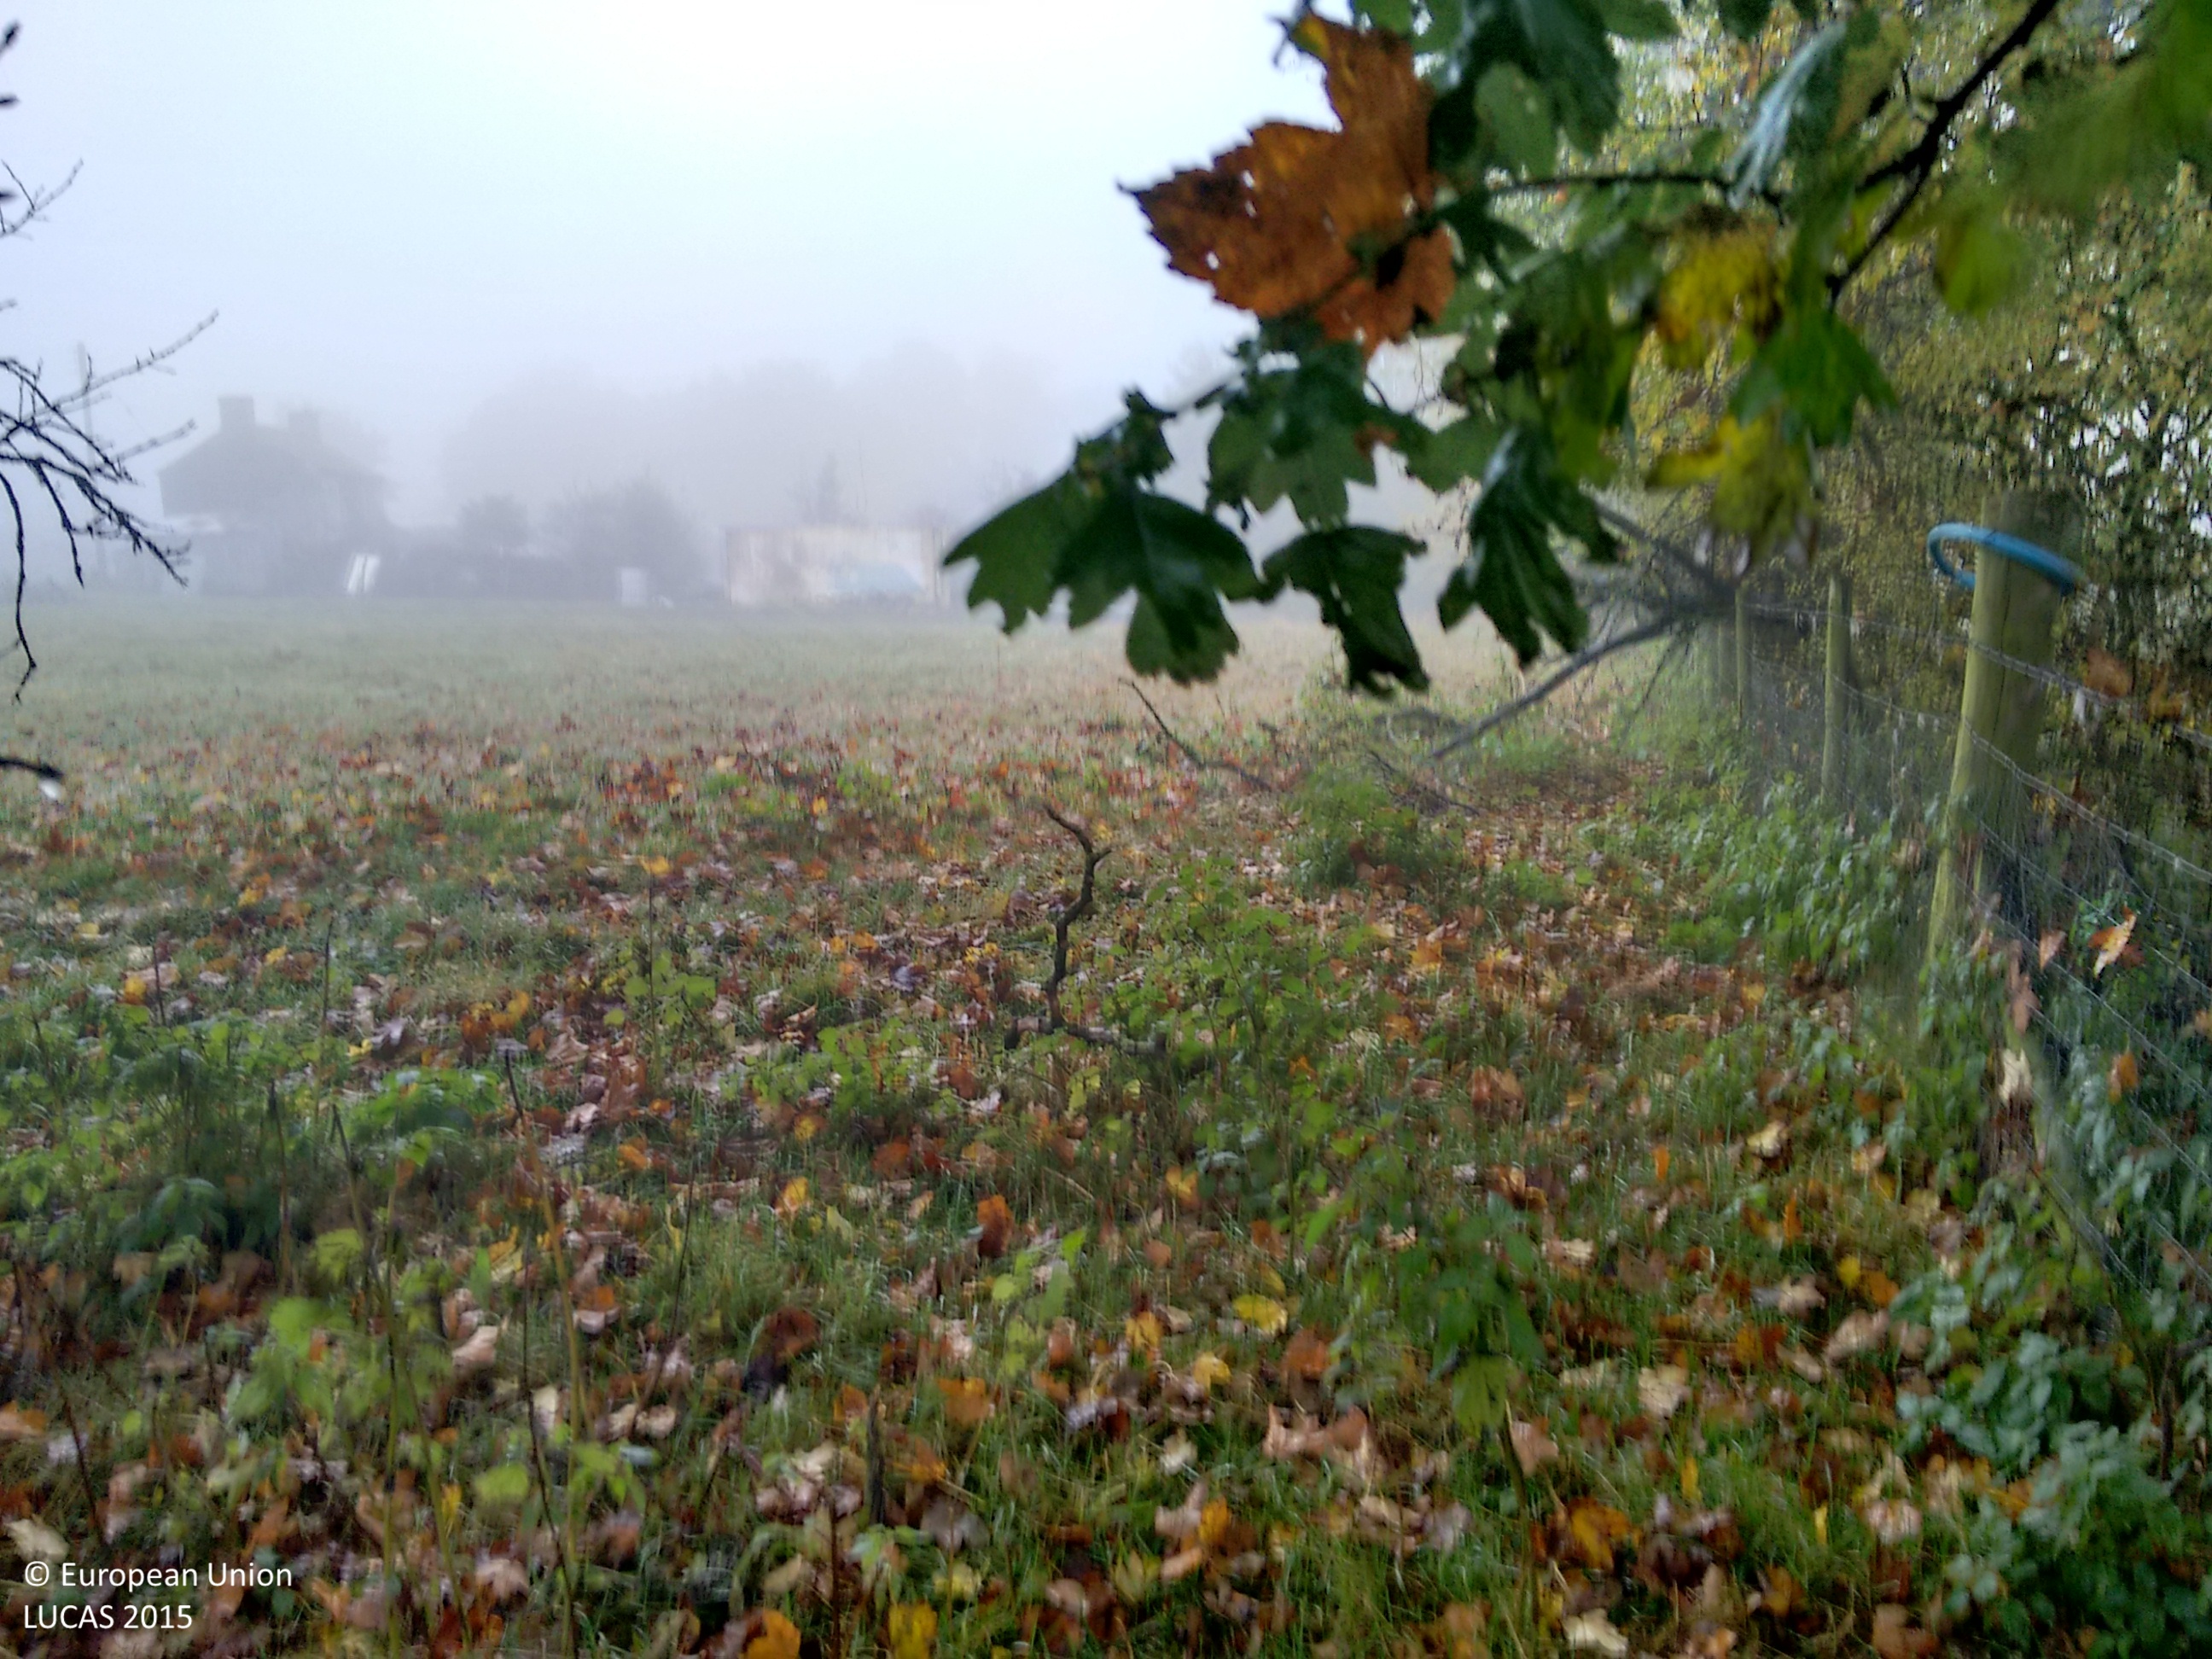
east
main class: Grassland
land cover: Grassland without tree/shrub cover
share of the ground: > 75 %
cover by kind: herbaceous plants 100 %
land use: Agriculture (excluding fallow land and kitchen gardens)
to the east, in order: Grassland without tree/shrub cover; Fences; Abandoned hedges; Grassland without tree/shrub cover; Fences; Abandoned hedges; Artificial constructions in urban areas; Grassland without tree/shrub cover
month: October
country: GB
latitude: 54.5187
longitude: -1.9346
